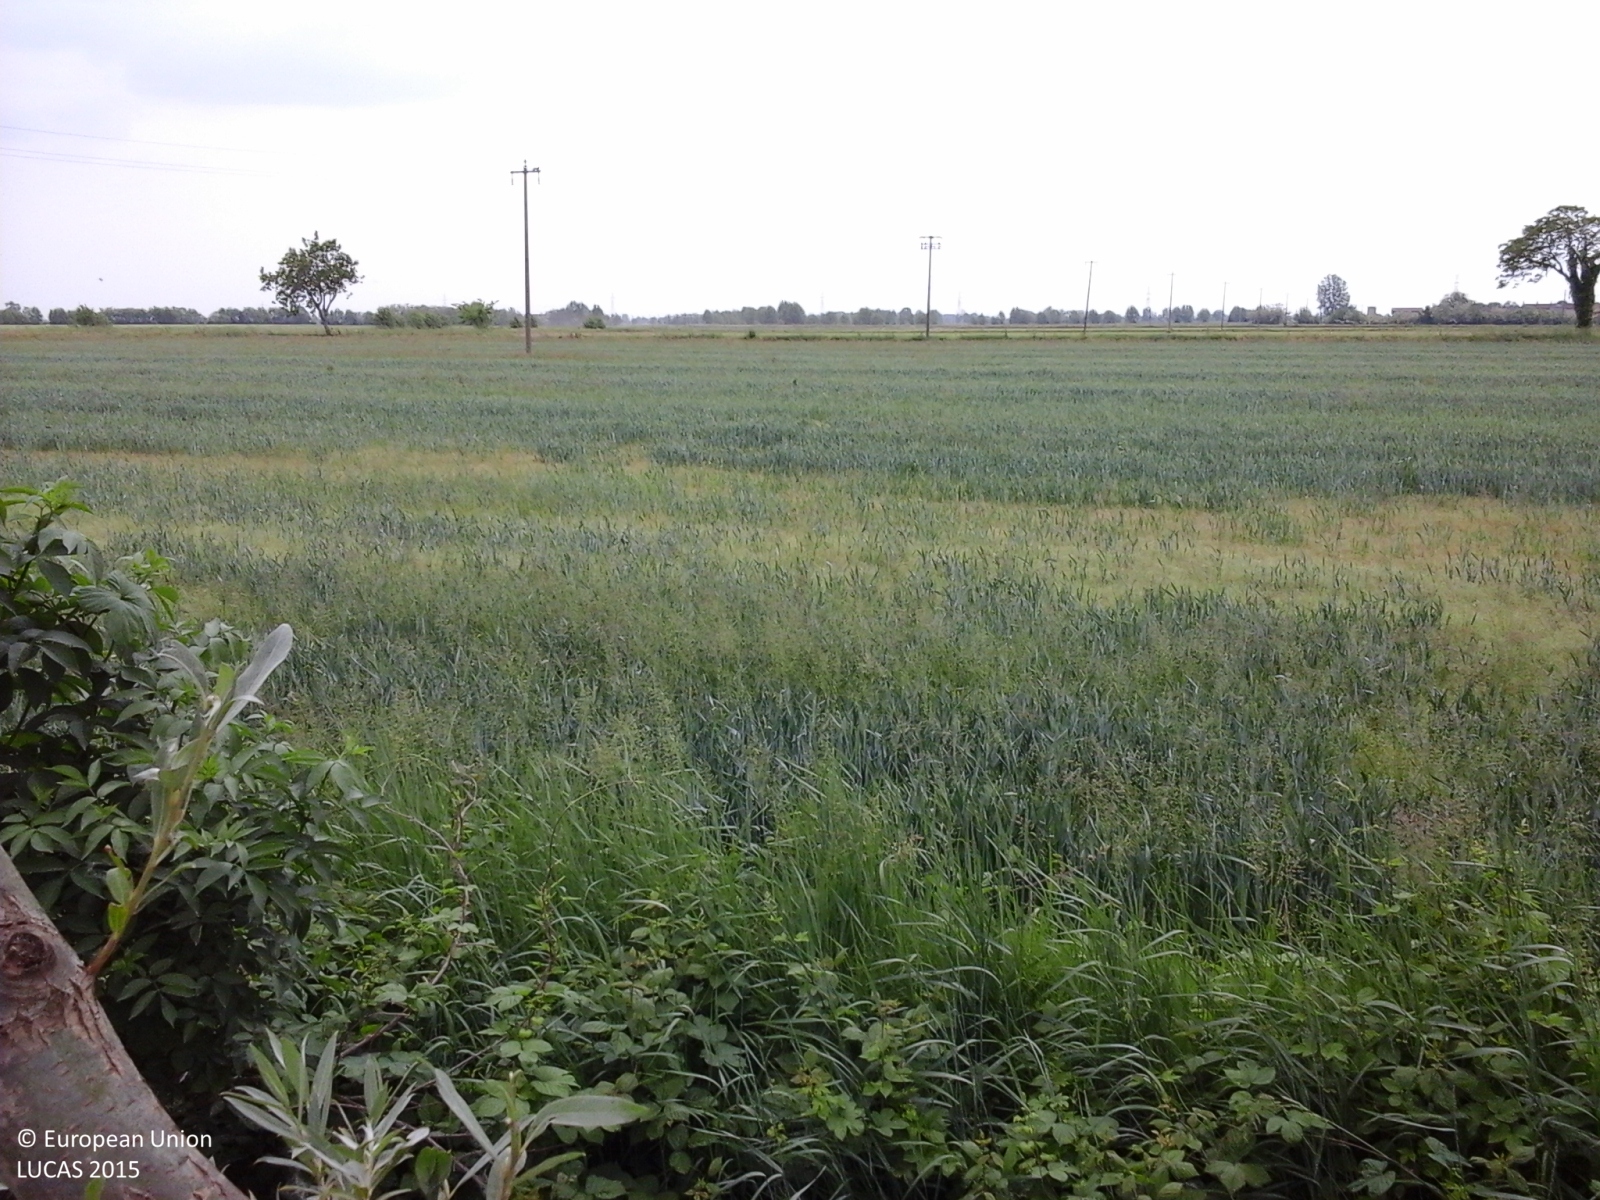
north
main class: Cropland
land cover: Common wheat
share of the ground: > 75 %
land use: Agriculture (excluding fallow land and kitchen gardens)
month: May
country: IT
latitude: 45.1799
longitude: 9.9111
